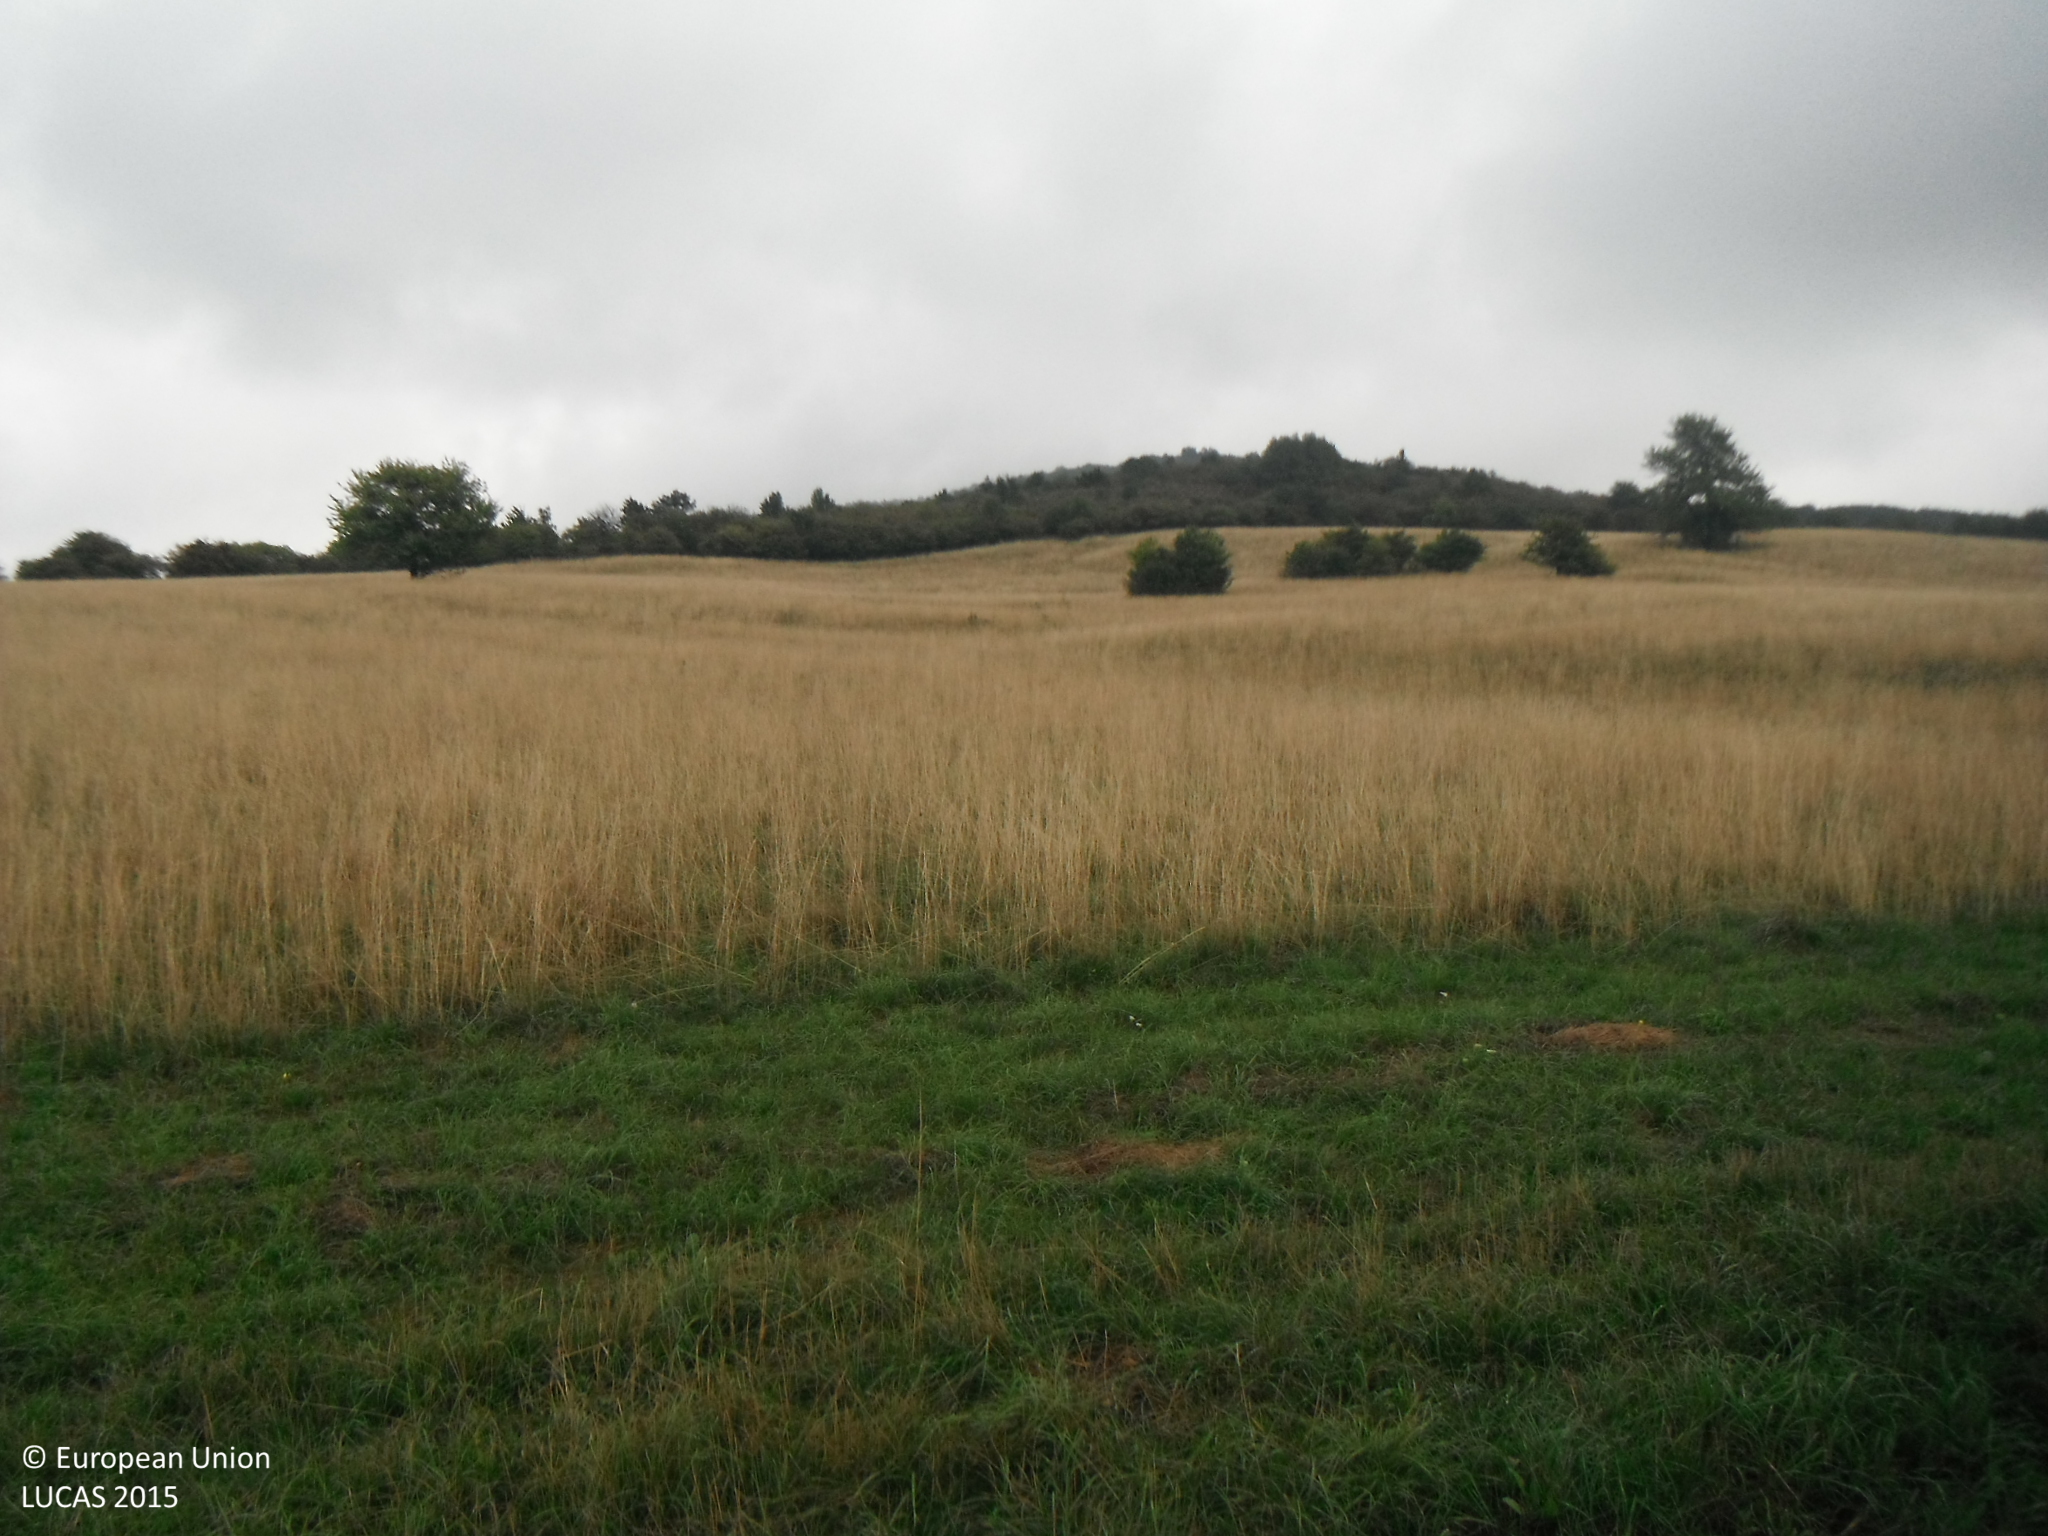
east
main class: Grassland
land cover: Grassland without tree/shrub cover
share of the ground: > 75 %
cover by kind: herbaceous plants 95 %, shrubs 5 %
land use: Agriculture (excluding fallow land and kitchen gardens)
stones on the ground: < 10 %
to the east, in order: Grassland without tree/shrub cover; Fences; Abandoned hedges; Grassland without tree/shrub cover; Single bushes/trees; Grassland without tree/shrub cover; Single bushes/trees; Grassland without tree/shrub cover
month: September
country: SK
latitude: 48.8000
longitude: 17.4853
